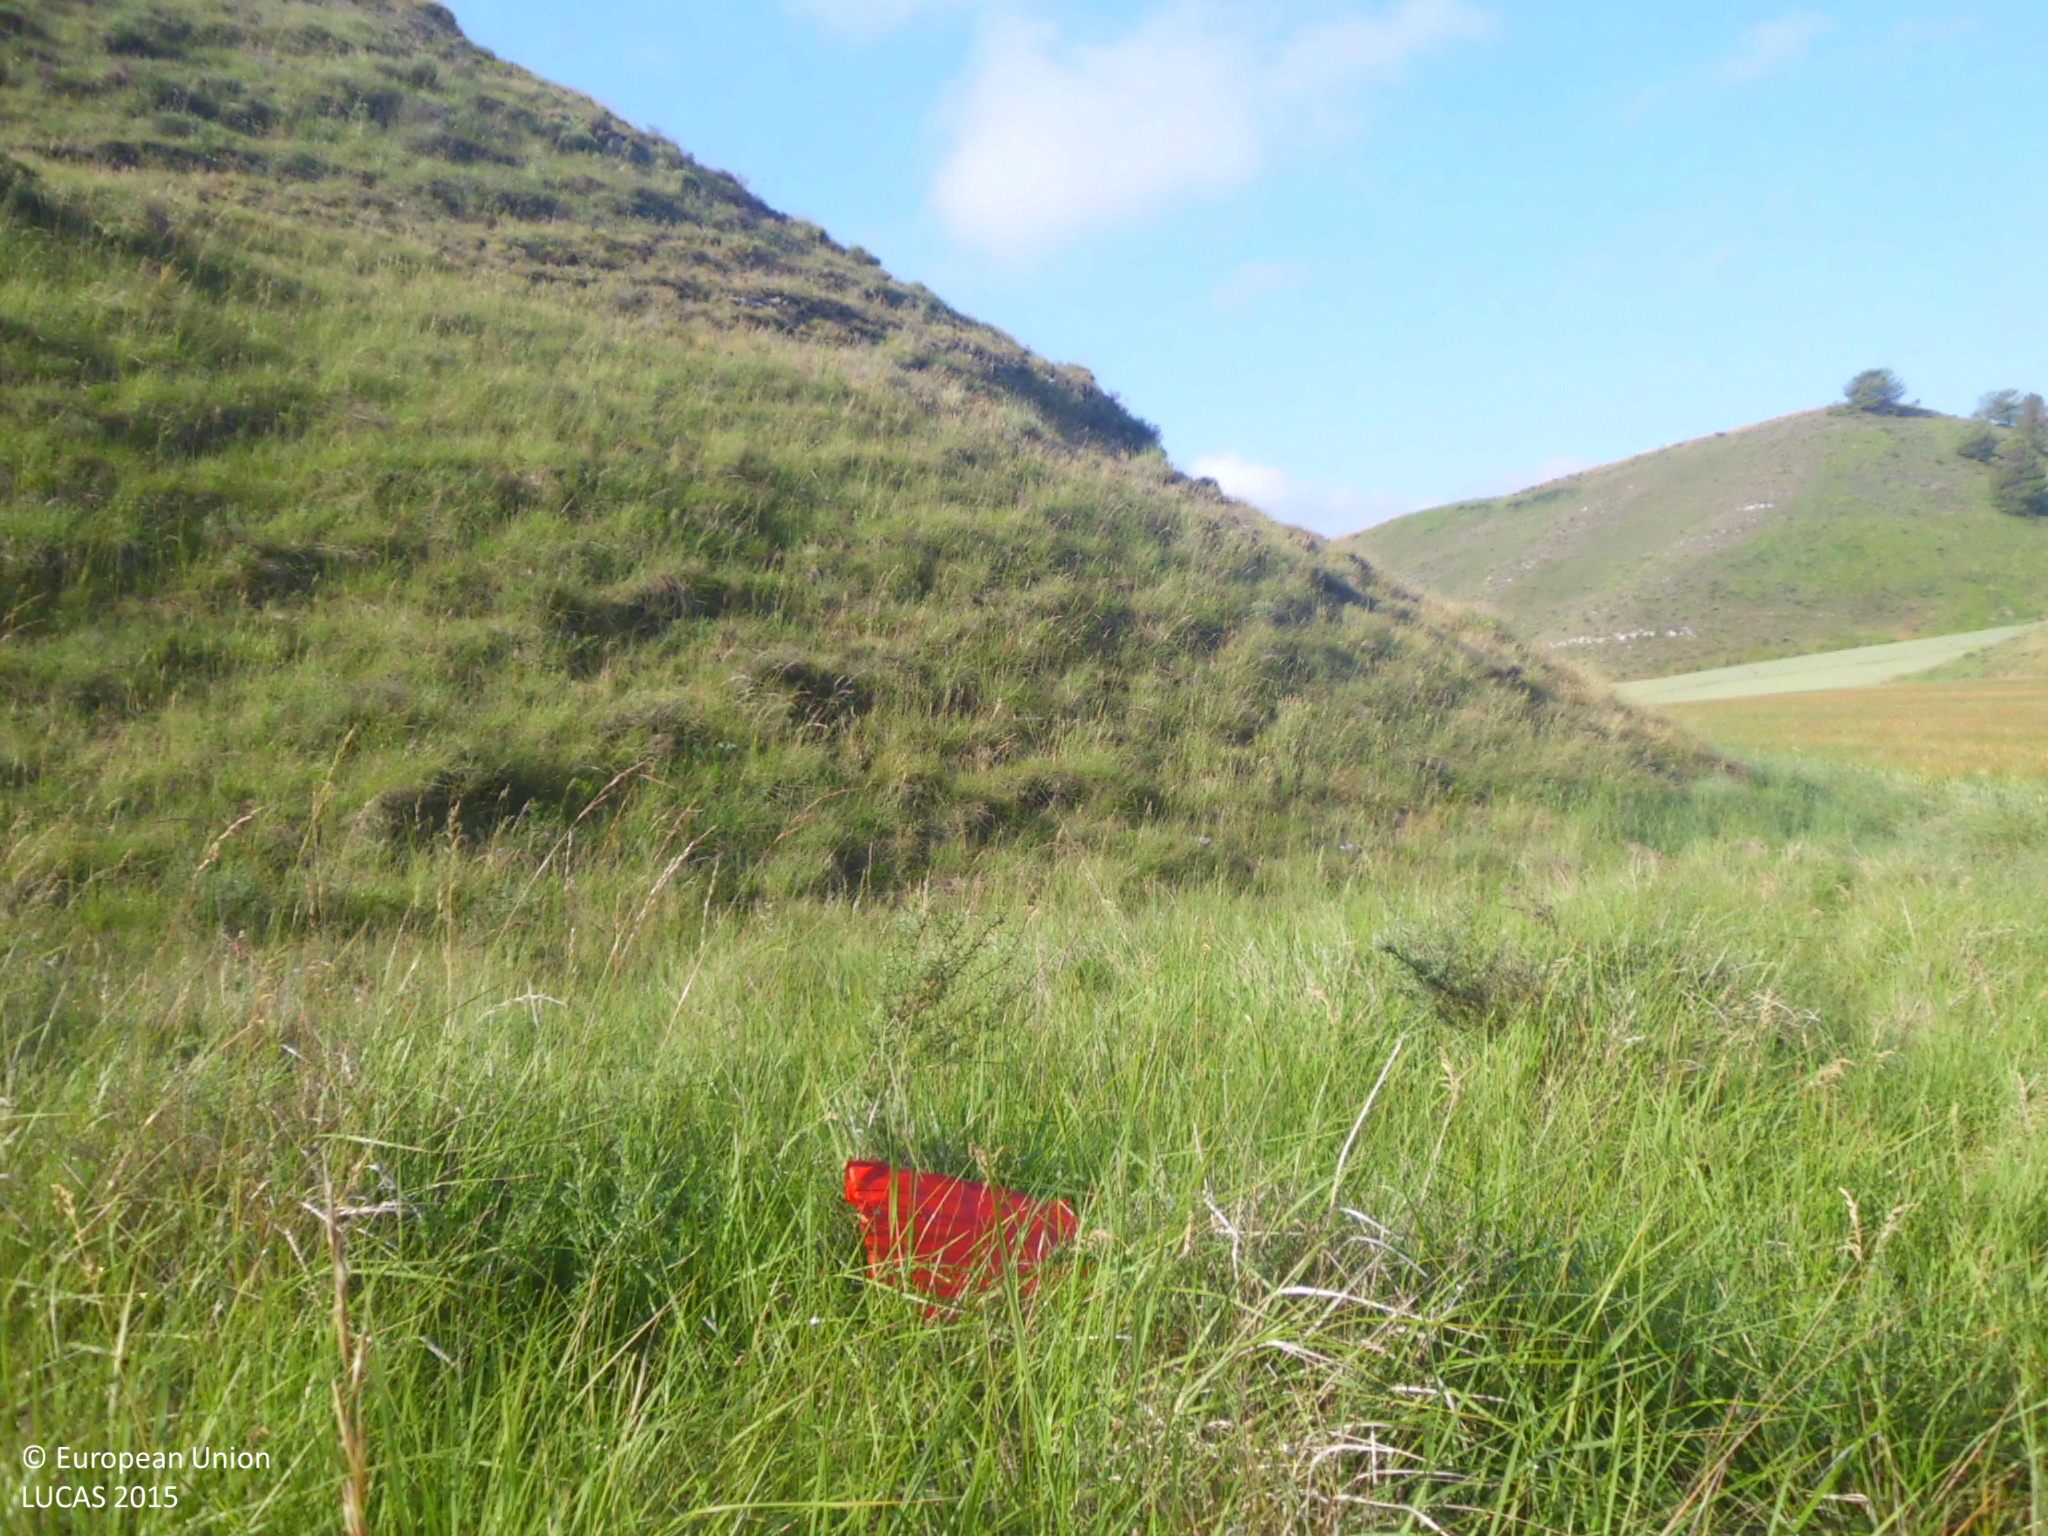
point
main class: Grassland
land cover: Grassland without tree/shrub cover
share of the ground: > 75 %
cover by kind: herbaceous plants 100 %
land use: Abandoned areas
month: June
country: ES
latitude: 42.5266
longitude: -3.2646
